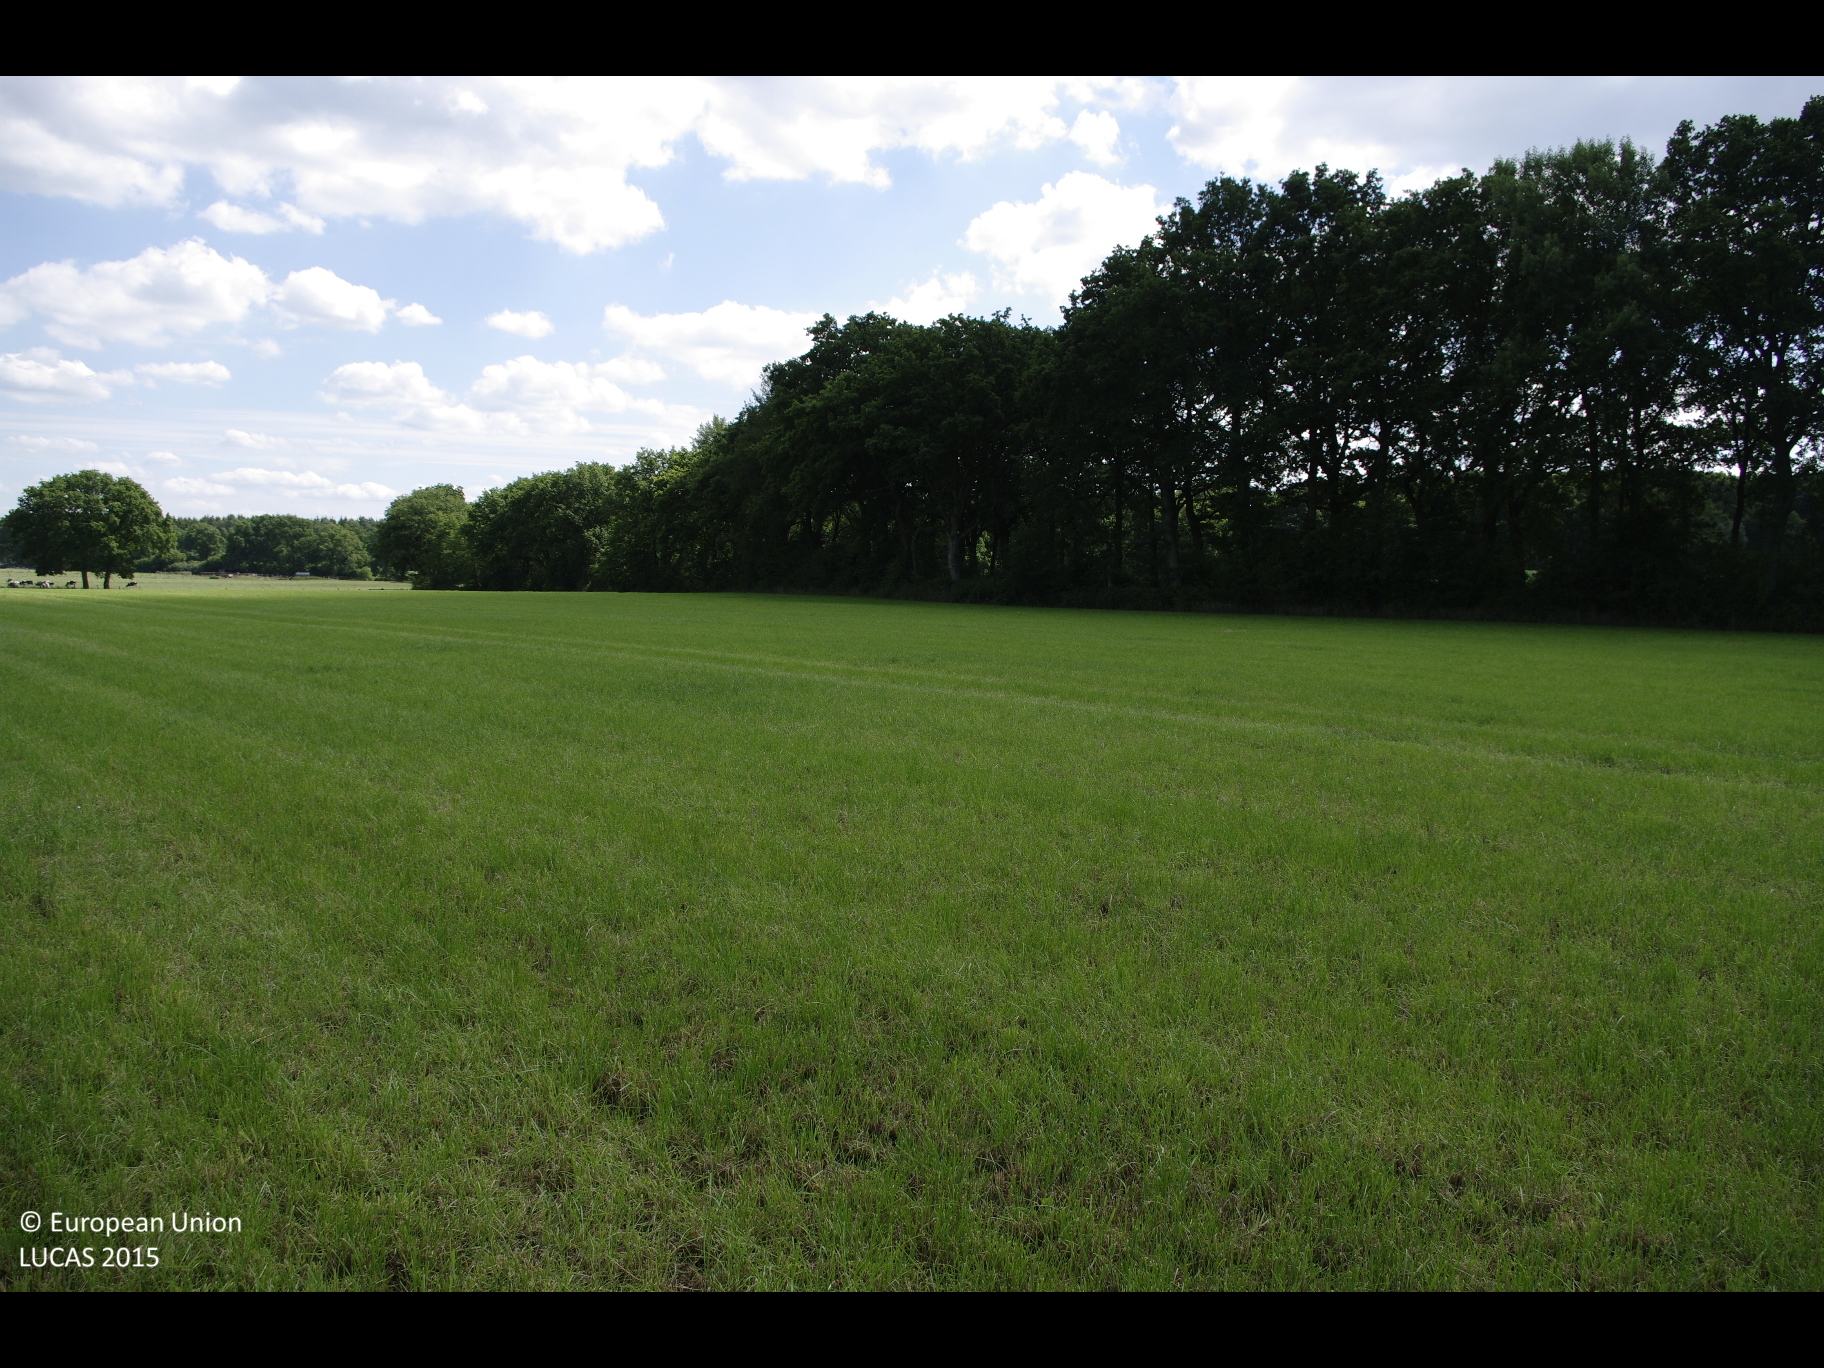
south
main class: Cropland
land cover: Temporary grasslands
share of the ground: > 75 %
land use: Agriculture (excluding fallow land and kitchen gardens)
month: July
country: DE
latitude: 53.8871
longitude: 9.8936
